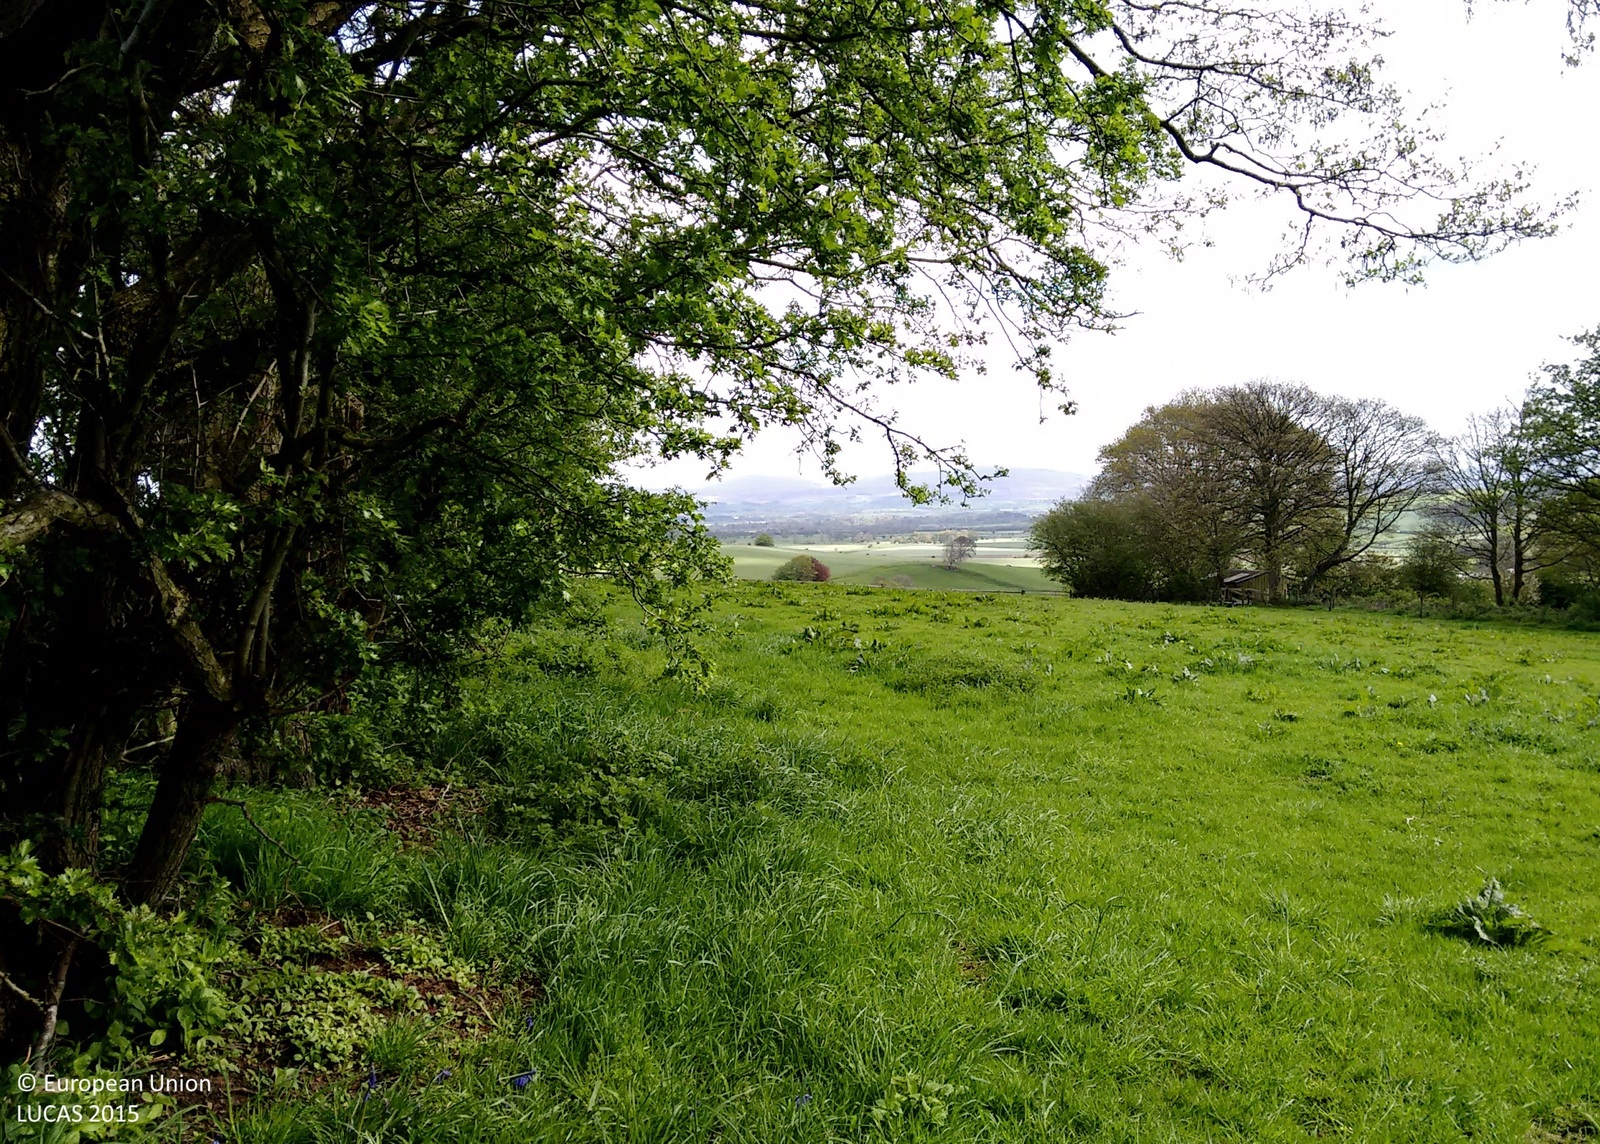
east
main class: Grassland
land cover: Grassland without tree/shrub cover
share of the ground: > 75 %
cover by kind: herbaceous plants 100 %
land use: Agriculture (excluding fallow land and kitchen gardens)
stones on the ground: < 10 %
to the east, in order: Grassland without tree/shrub cover; Spontaneously vegetated surfaces; Broadleaved woodland; Fences; Grass margins; Fences; Grassland without tree/shrub cover; Fences; Grass margins; Electric lines; Fences; Broadleaved woodland; Grassland without tree/shrub cover; Managed hedges; Paved roads, cycling and walking lanes; Managed hedges; Fences; Grassland without tree/shrub cover; Fences; Broadleaved woodland; Fences; Grassland without tree/shrub cover
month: May
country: GB
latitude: 54.1184
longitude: -2.6584
